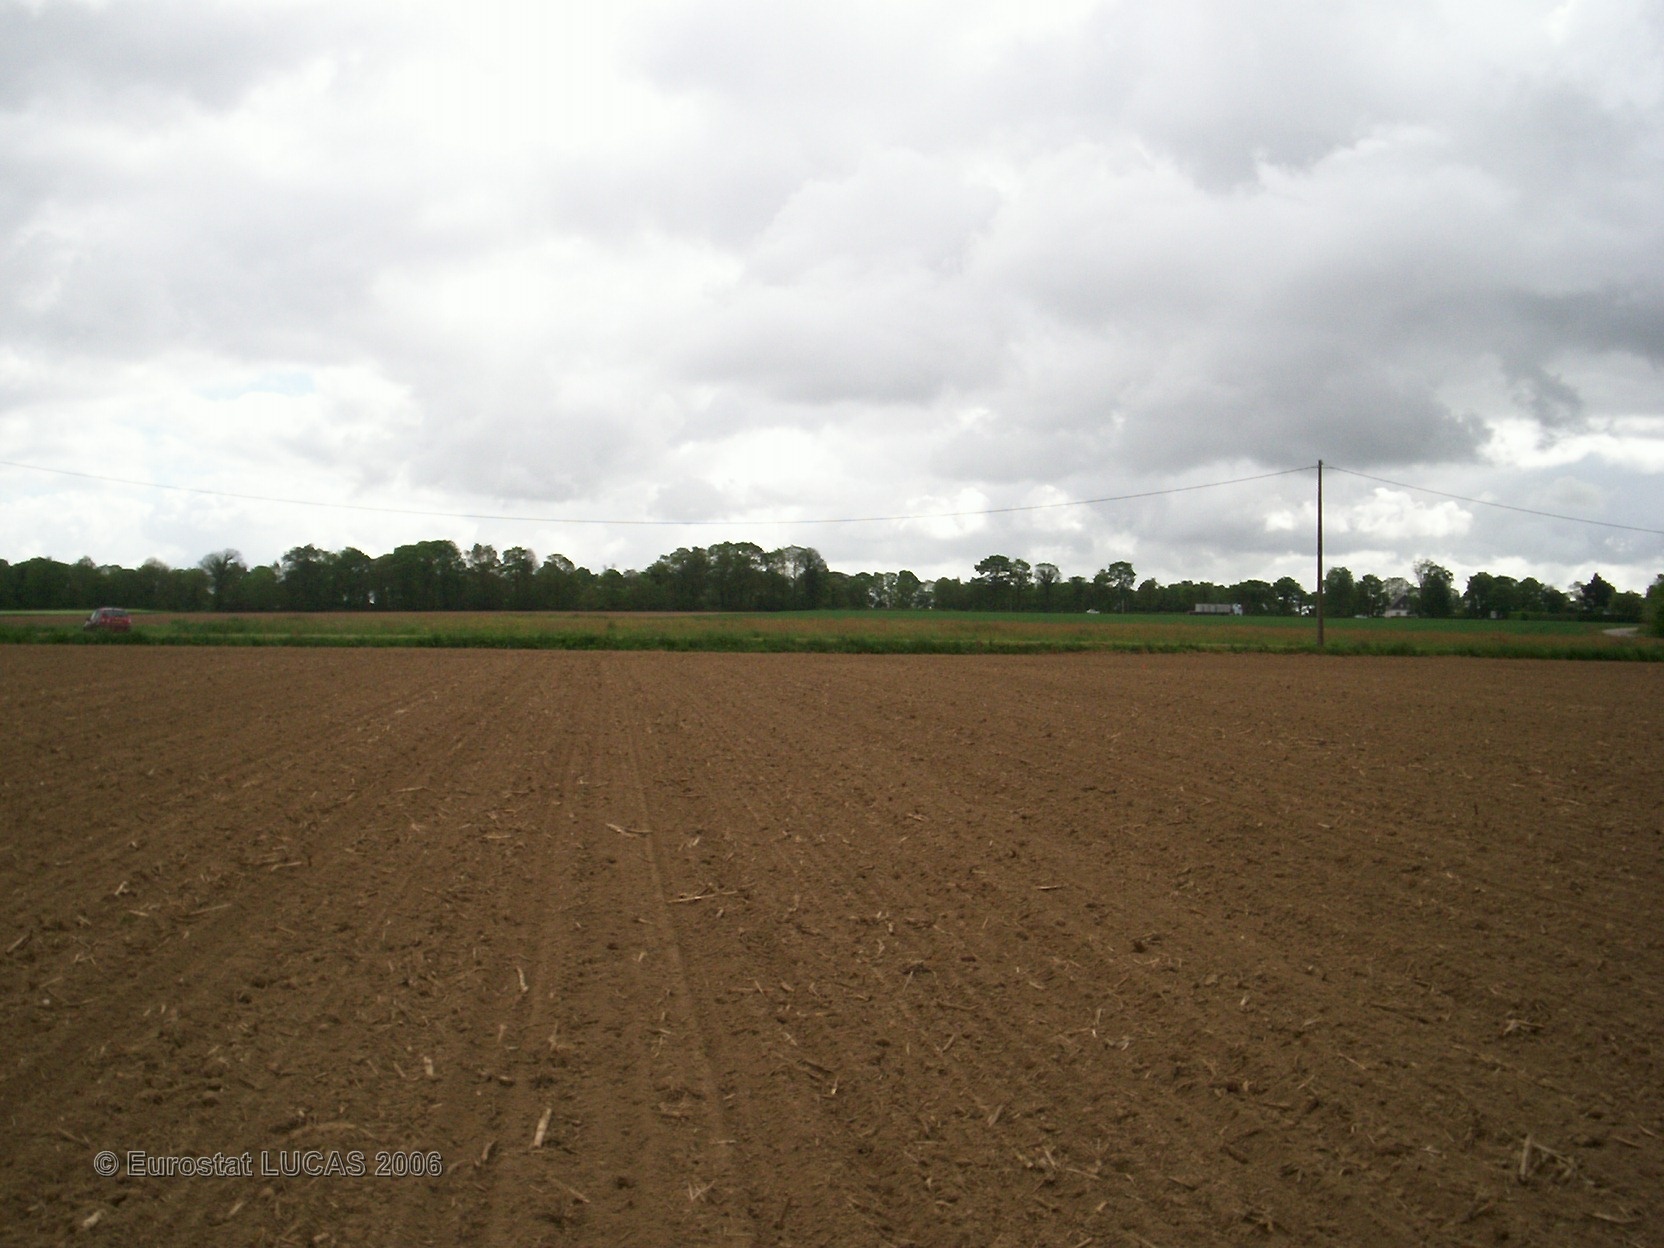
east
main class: Cropland
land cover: Maize
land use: Agriculture (excluding fallow land and kitchen gardens)
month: May
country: FR
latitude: 47.9237
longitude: -2.8455
